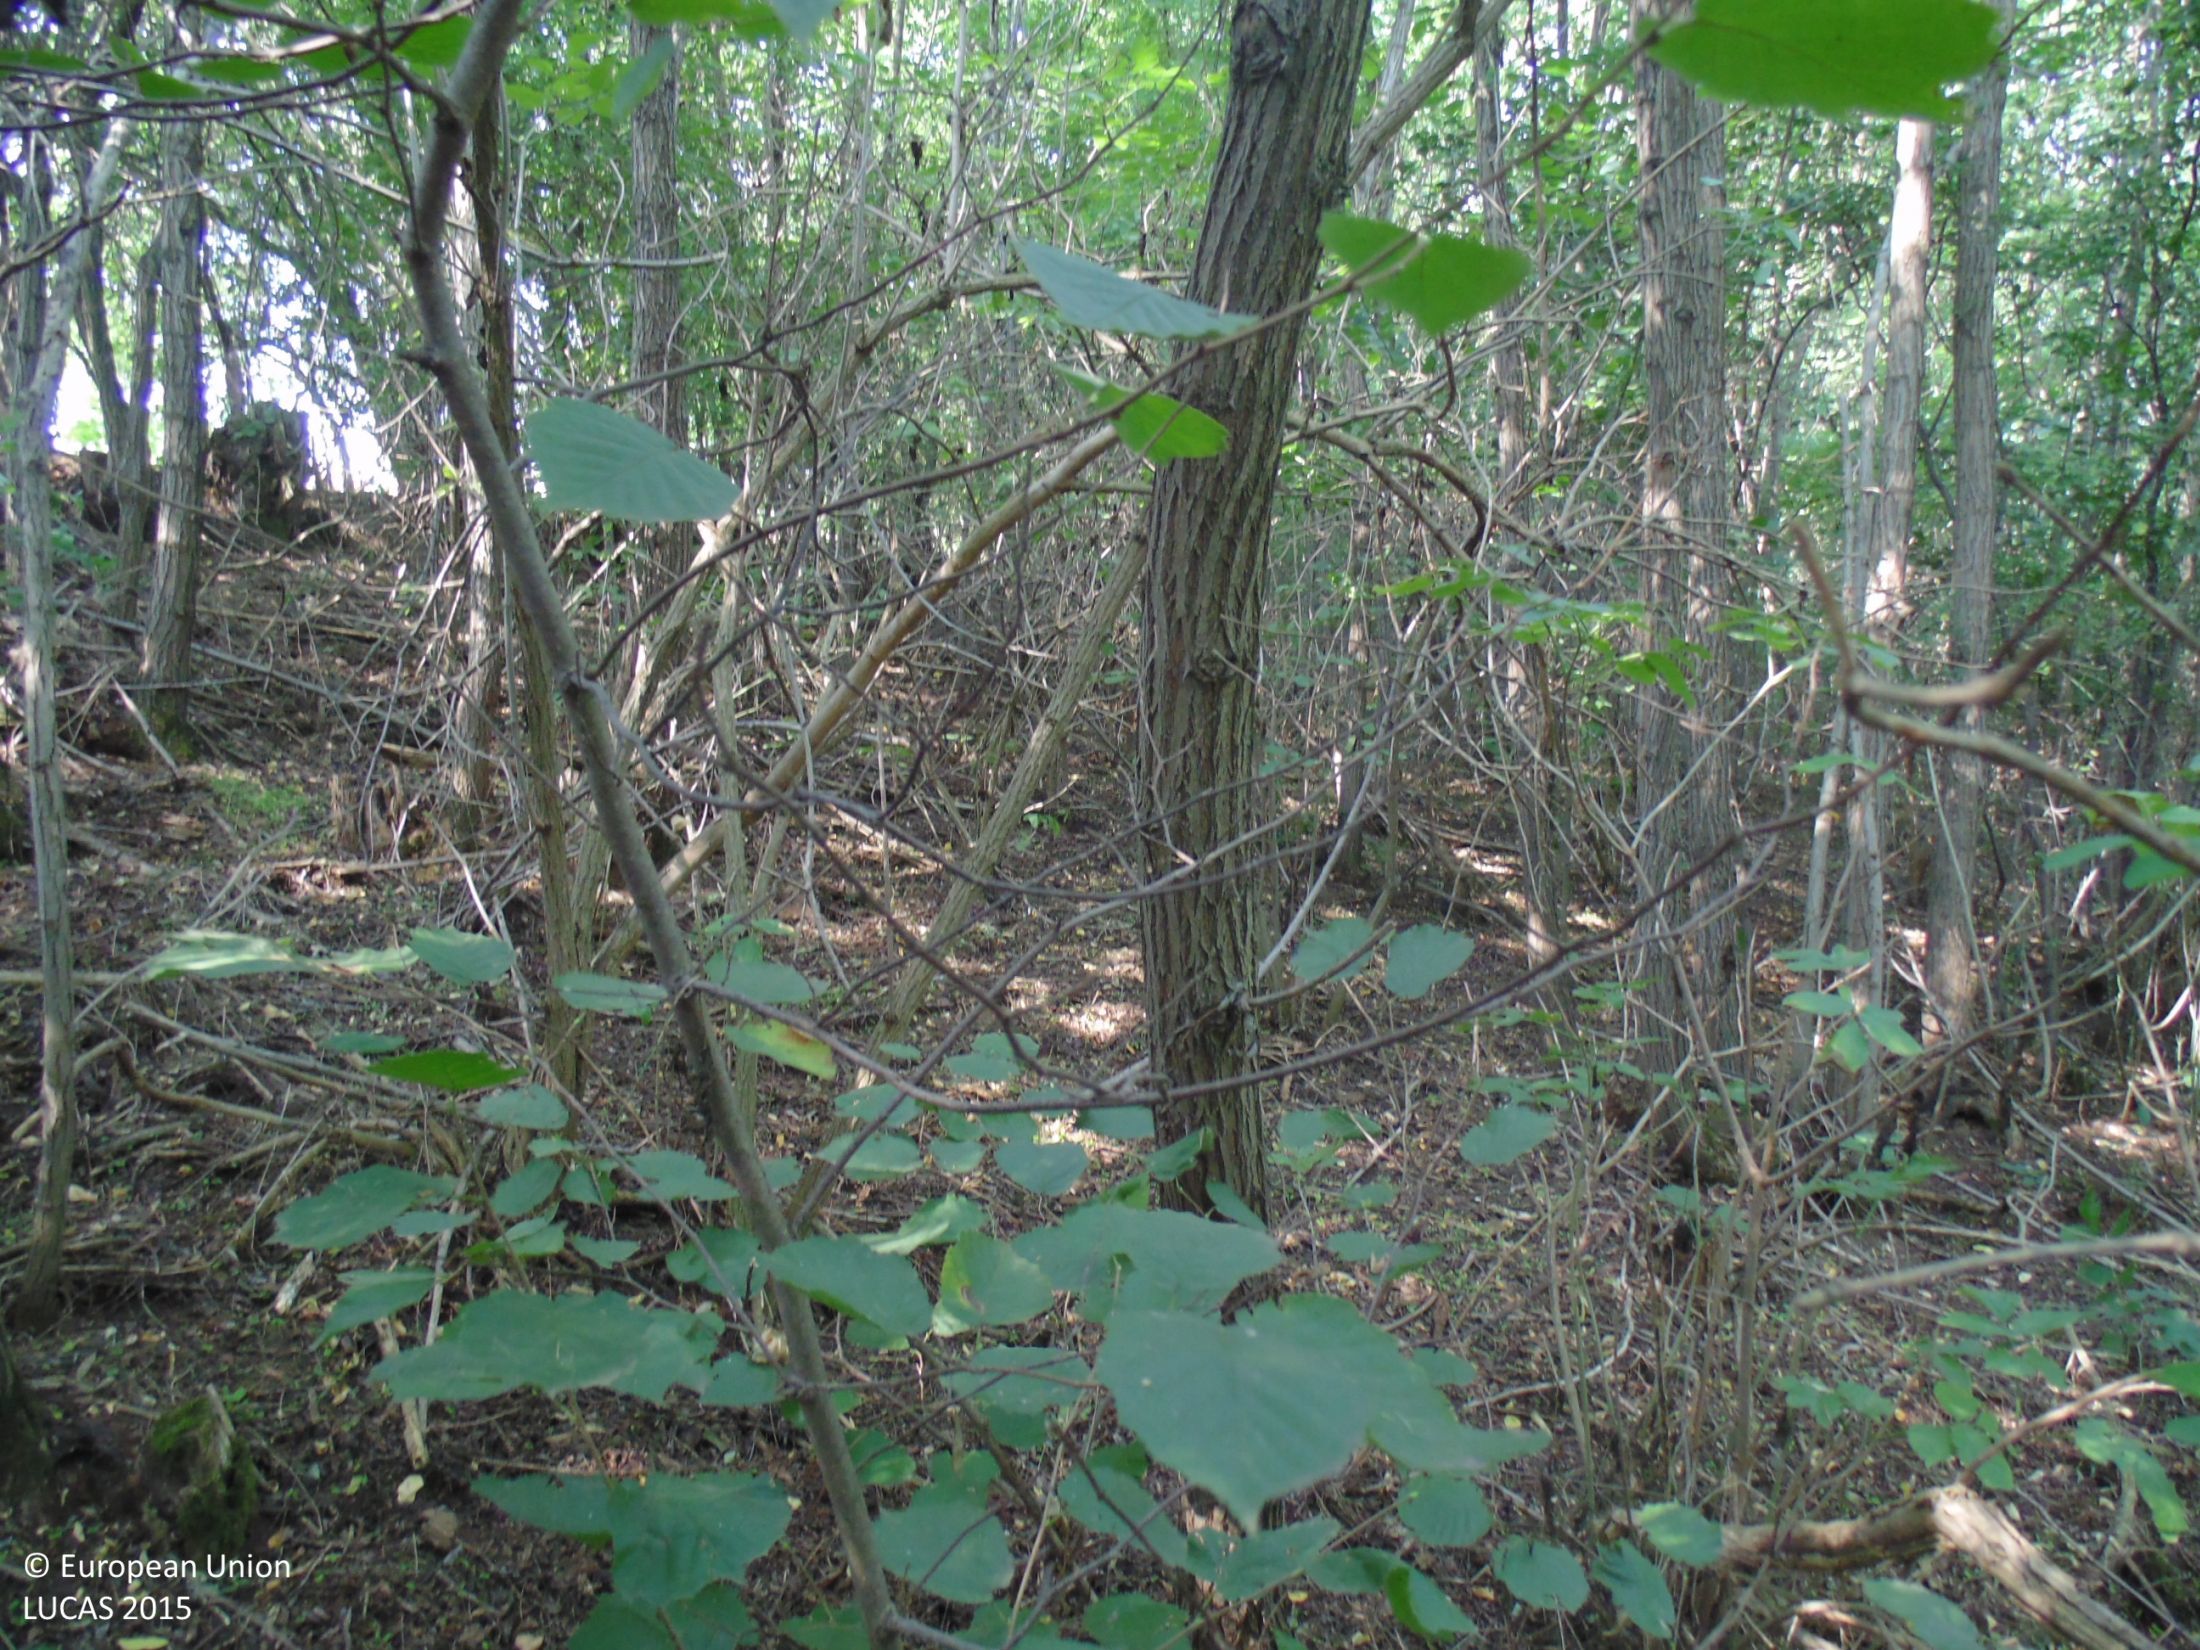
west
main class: Woodland
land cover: Broadleaved woodland
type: mesophytic deciduous forest
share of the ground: > 75 %
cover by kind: broadleaved forest trees 95 %, herbaceous plants 5 %
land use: Forestry
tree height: > 5 m
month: August
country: BG
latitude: 44.0545
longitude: 27.3465
